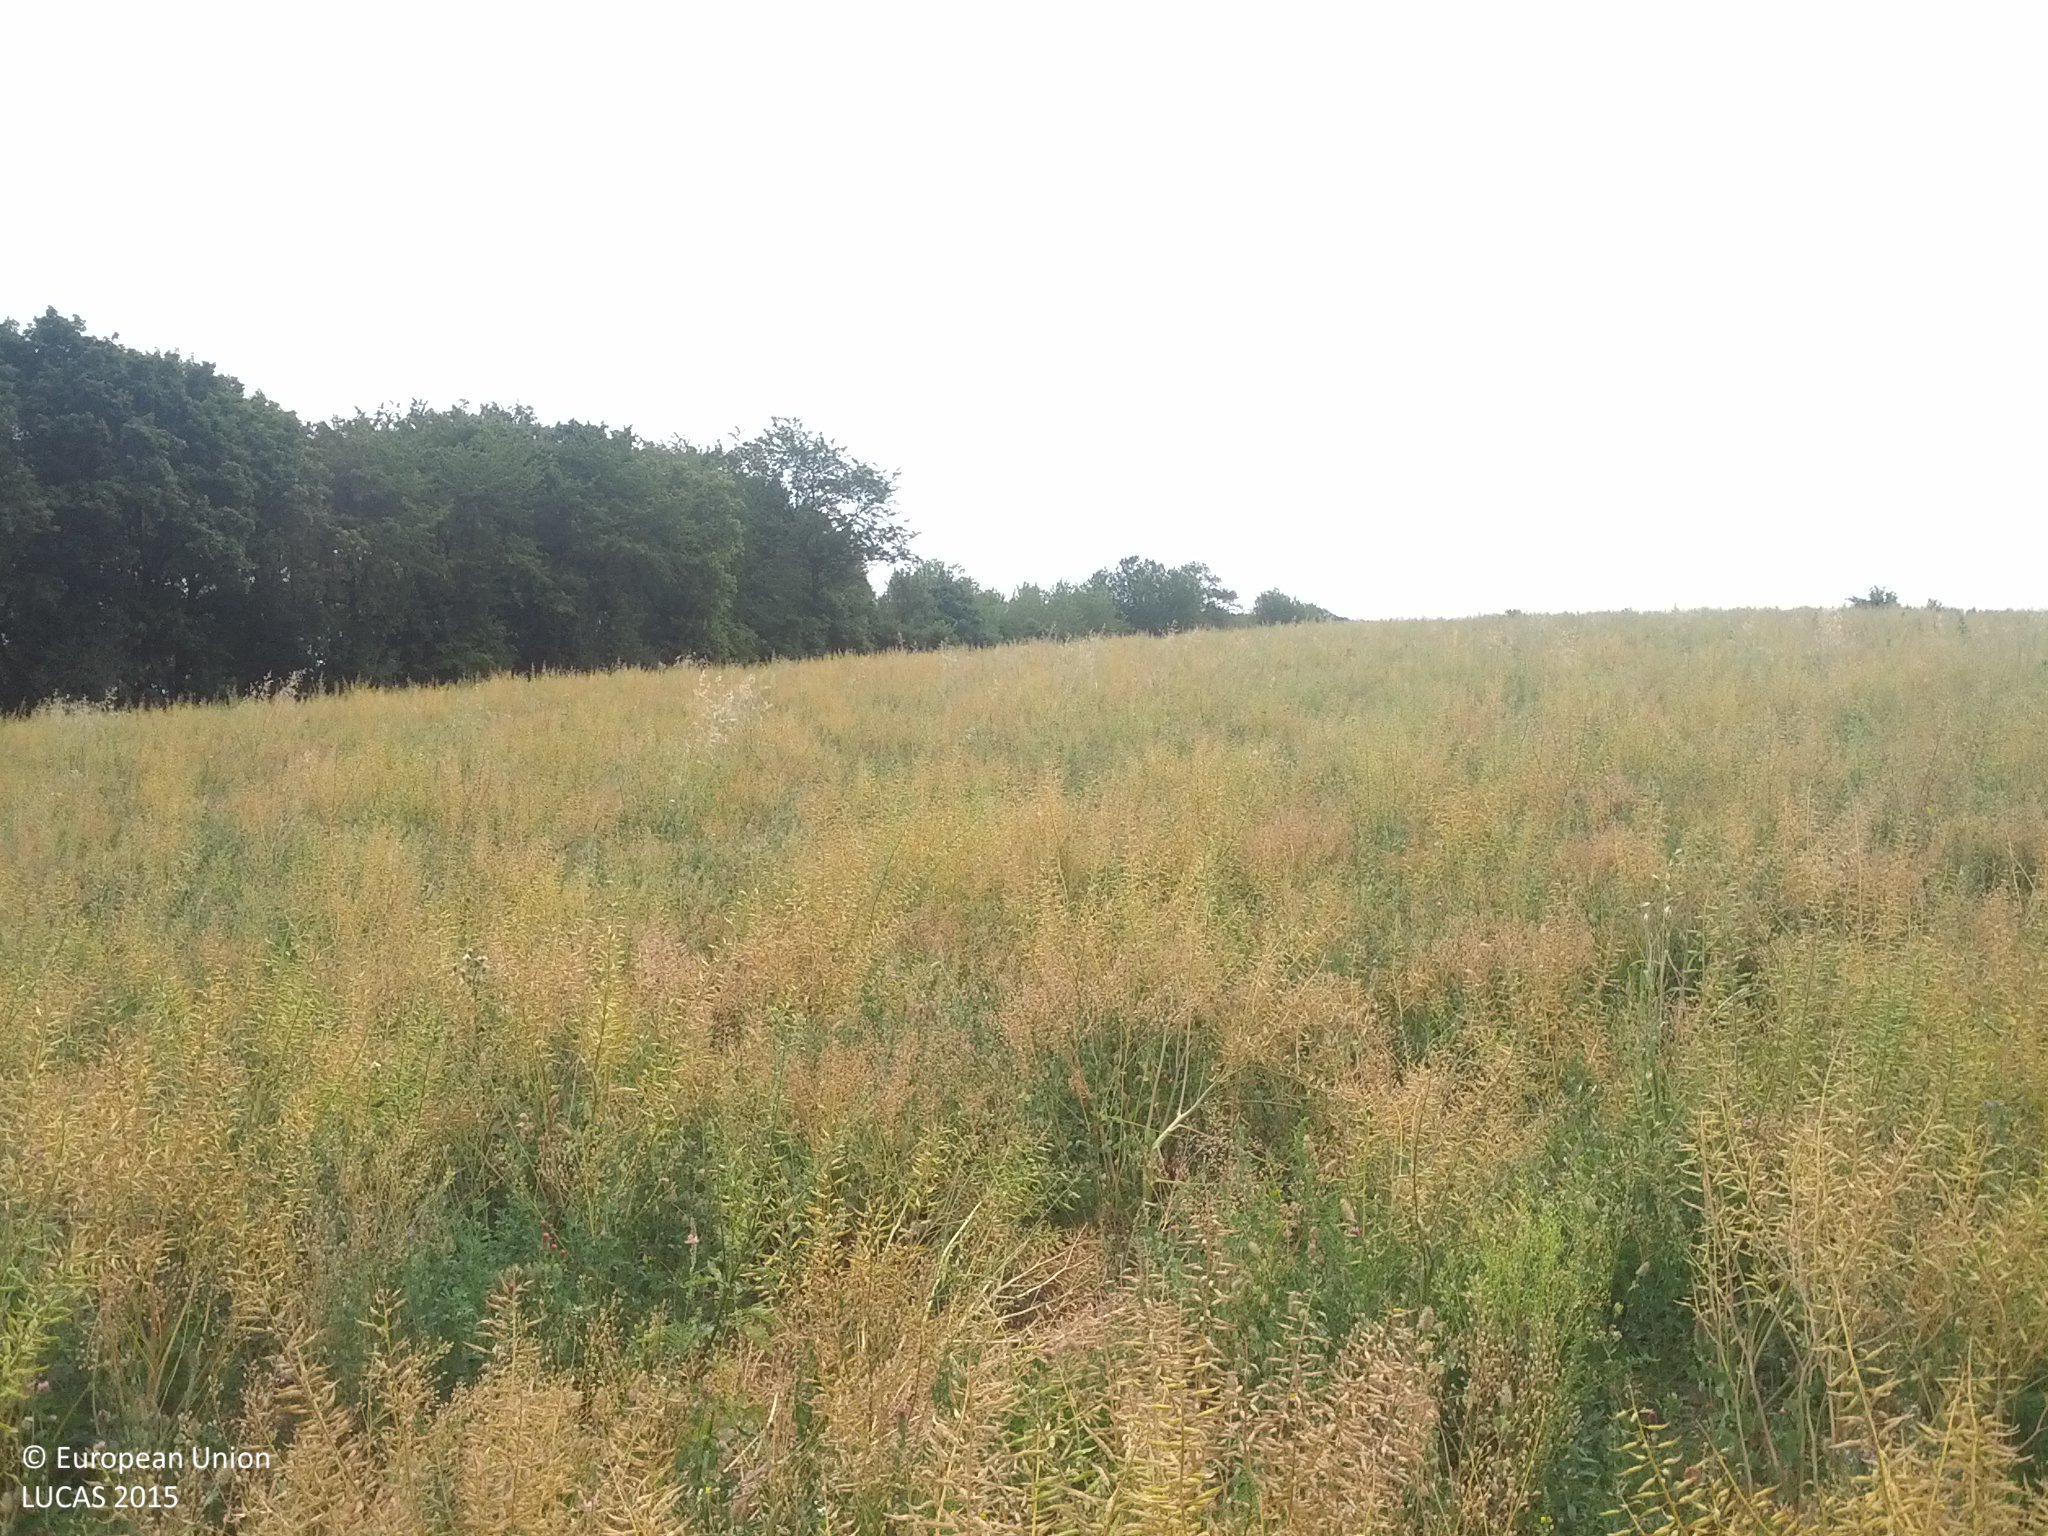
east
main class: Cropland
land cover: Other fibre and oleaginous crops
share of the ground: > 75 %
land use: Agriculture (excluding fallow land and kitchen gardens)
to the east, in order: Other fibre and oleaginous crops; Temporary grasslands; Broadleaved woodland; Tracks; Broadleaved woodland
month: July
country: AT
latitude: 48.5202
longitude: 16.1651
